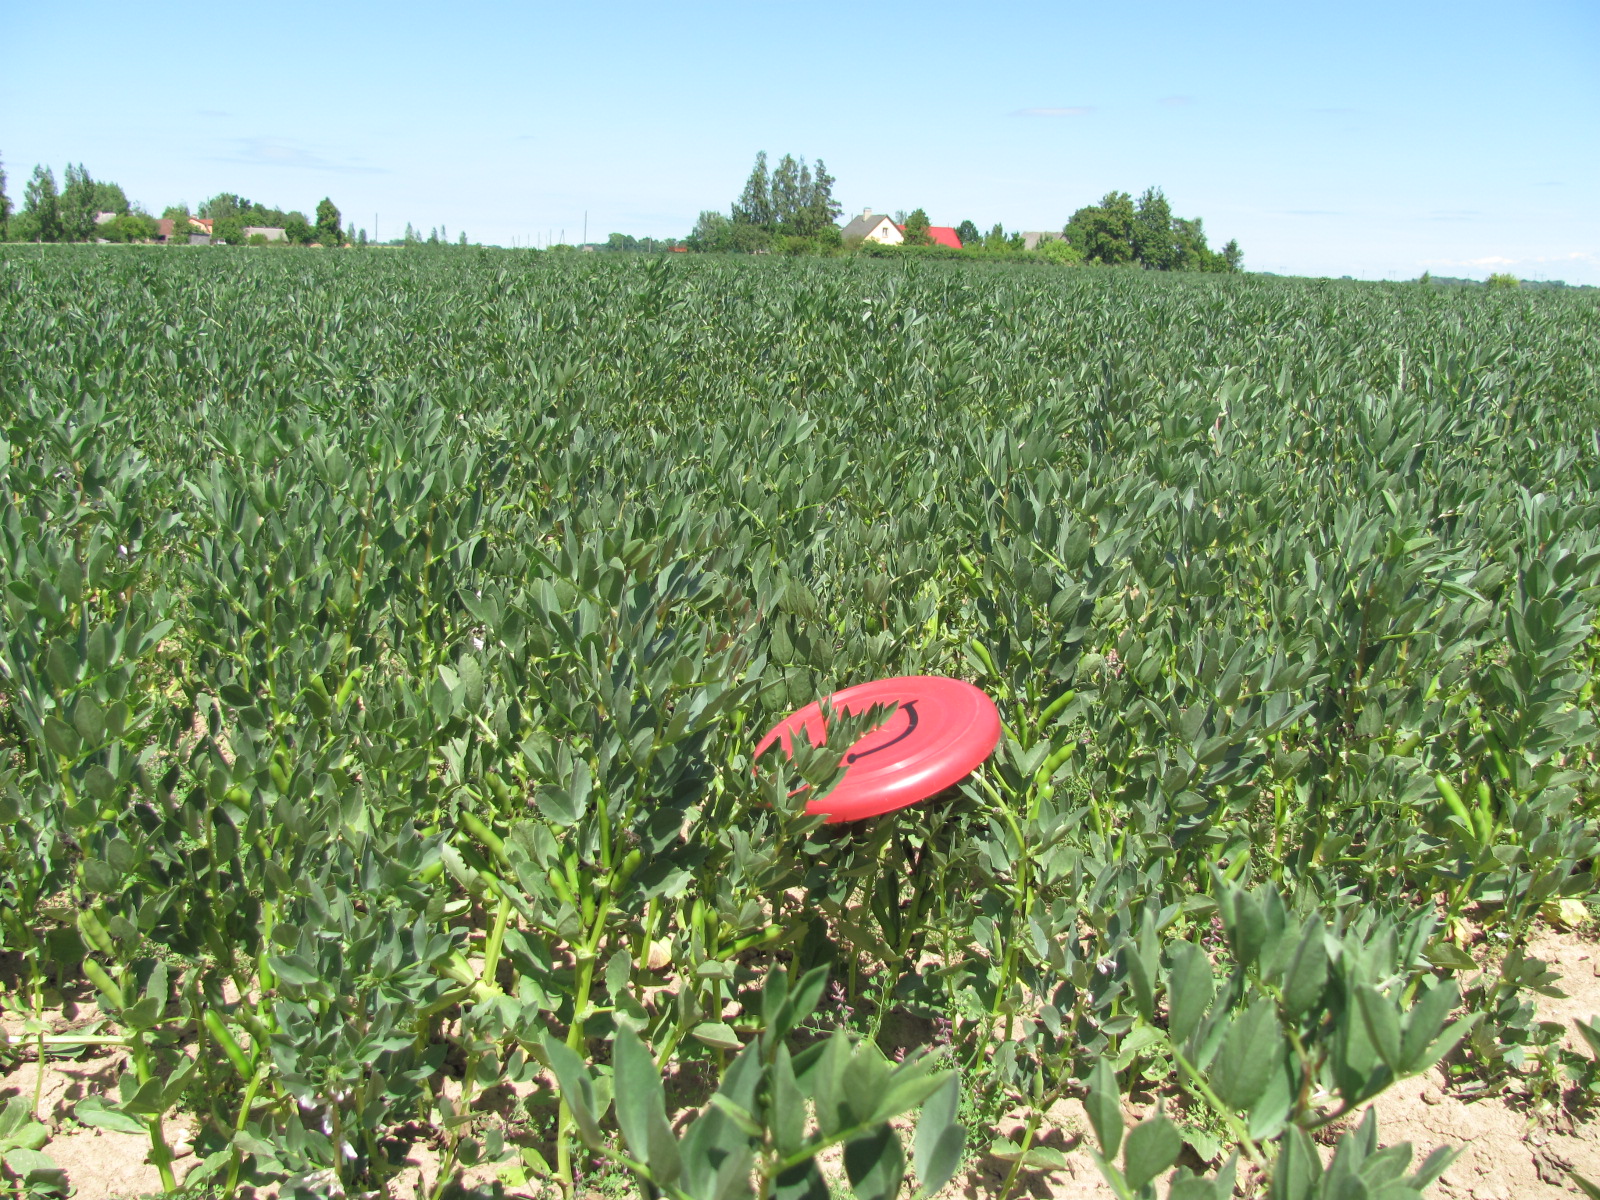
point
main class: Cropland
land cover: Dry pulses
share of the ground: > 75 %
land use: Agriculture (excluding fallow land and kitchen gardens)
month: July
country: LV
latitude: 56.4539
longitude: 23.6924
